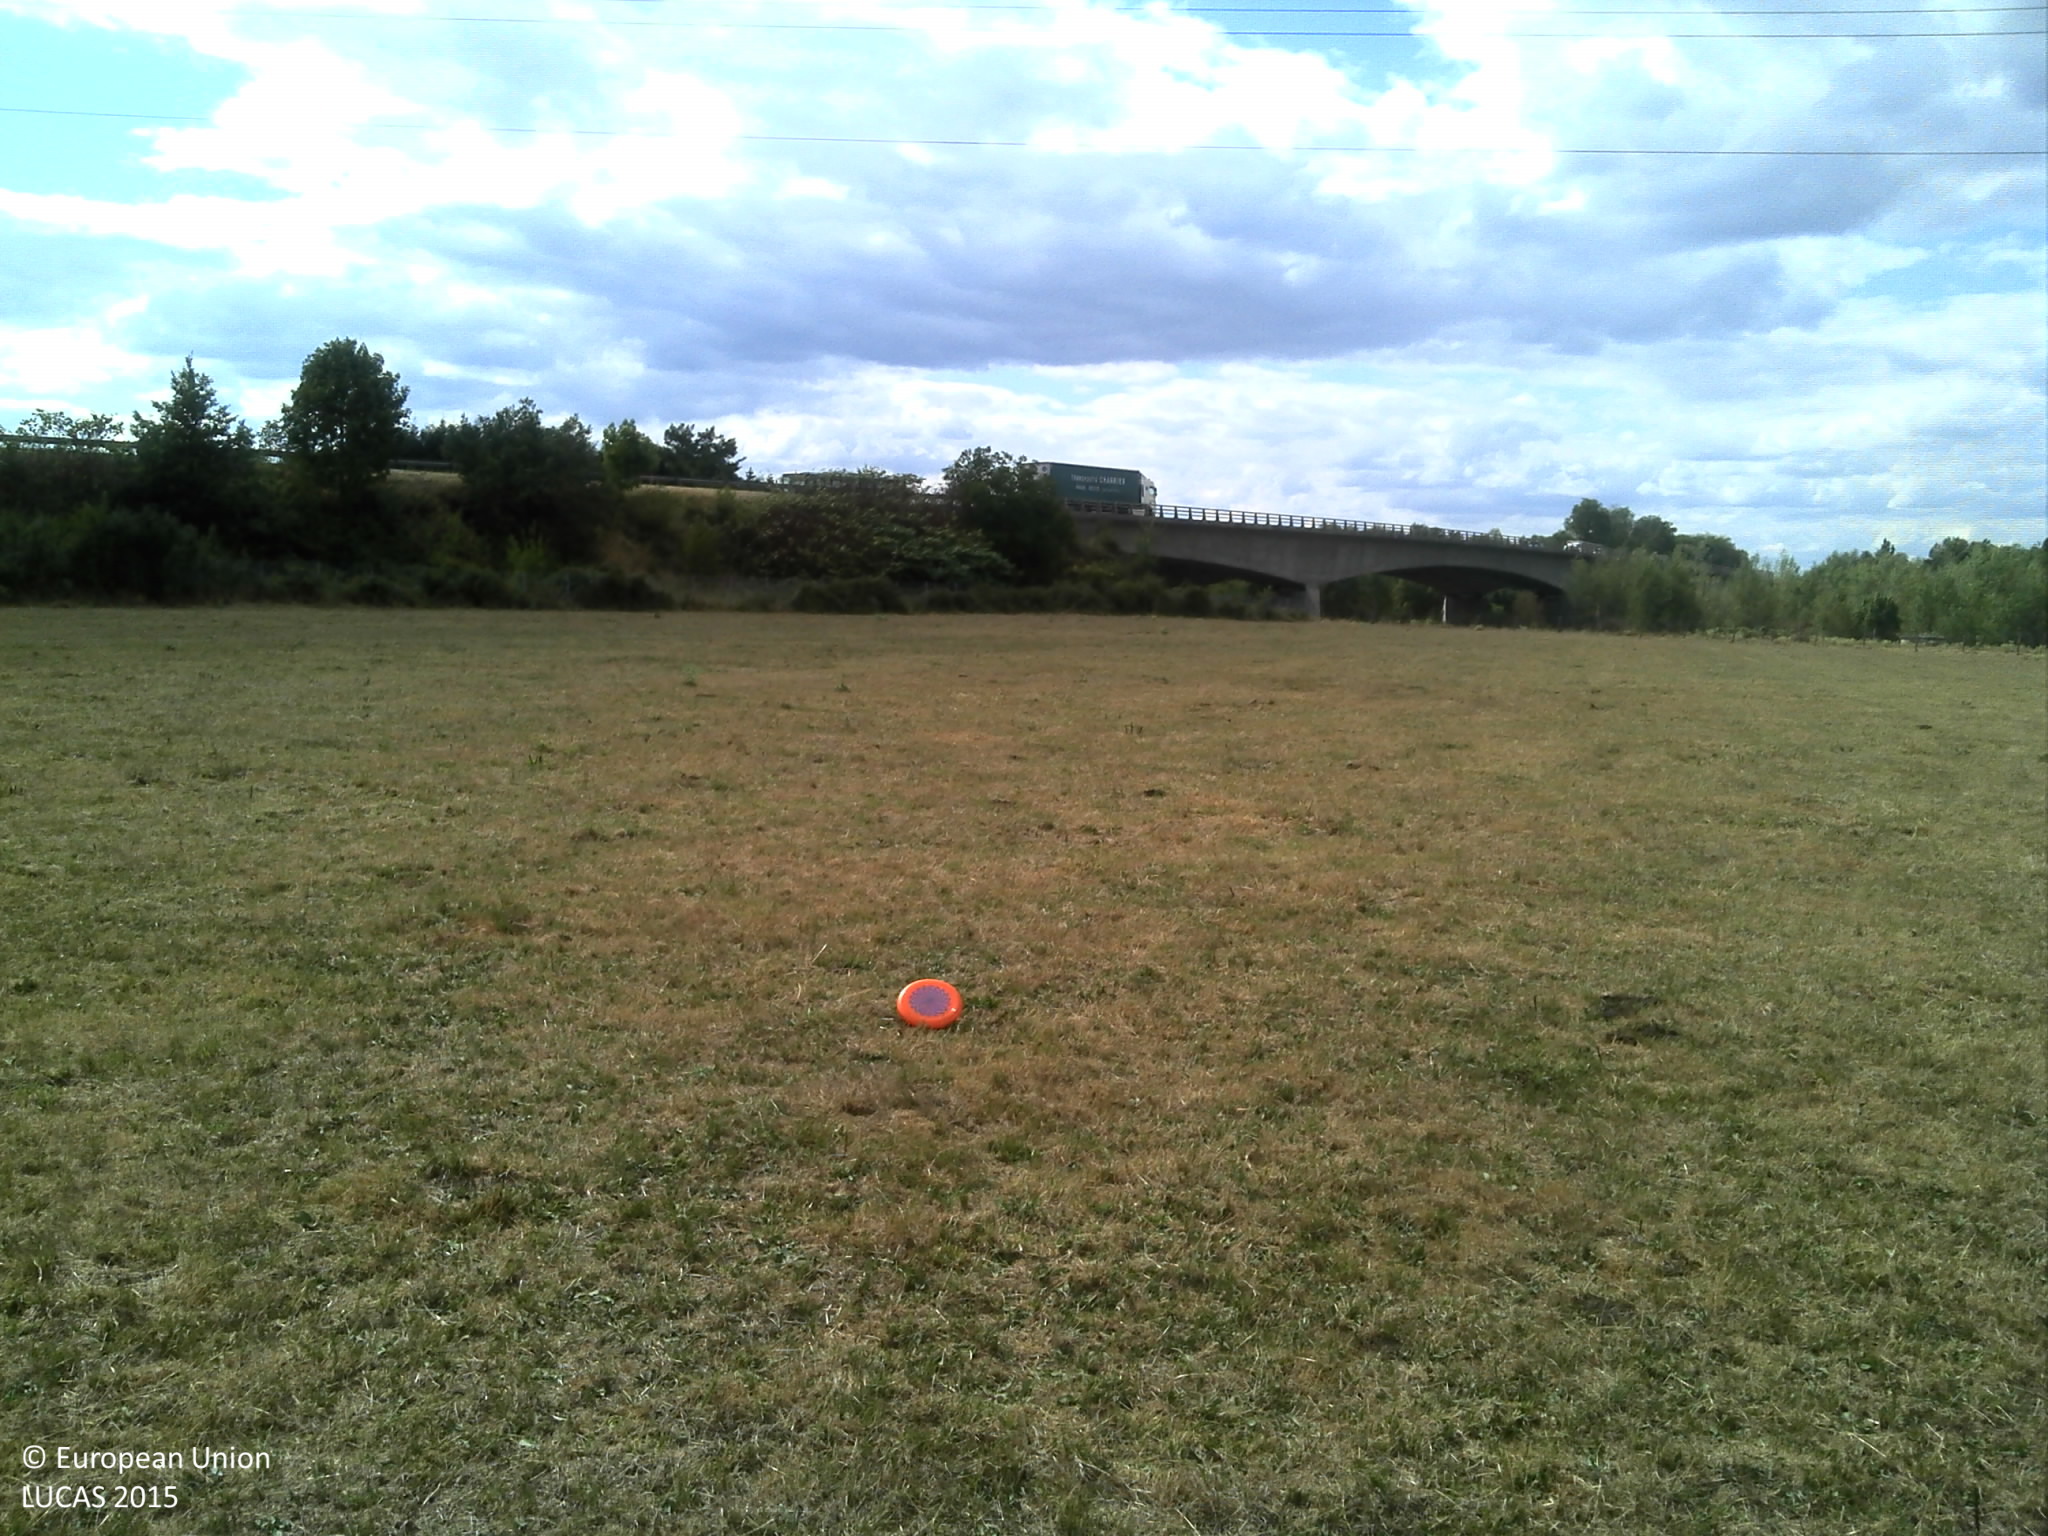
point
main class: Grassland
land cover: Grassland without tree/shrub cover
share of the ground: > 75 %
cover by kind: herbaceous plants 100 %
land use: Agriculture (excluding fallow land and kitchen gardens)
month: July
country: FR
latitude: 46.0436
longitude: 4.0960
